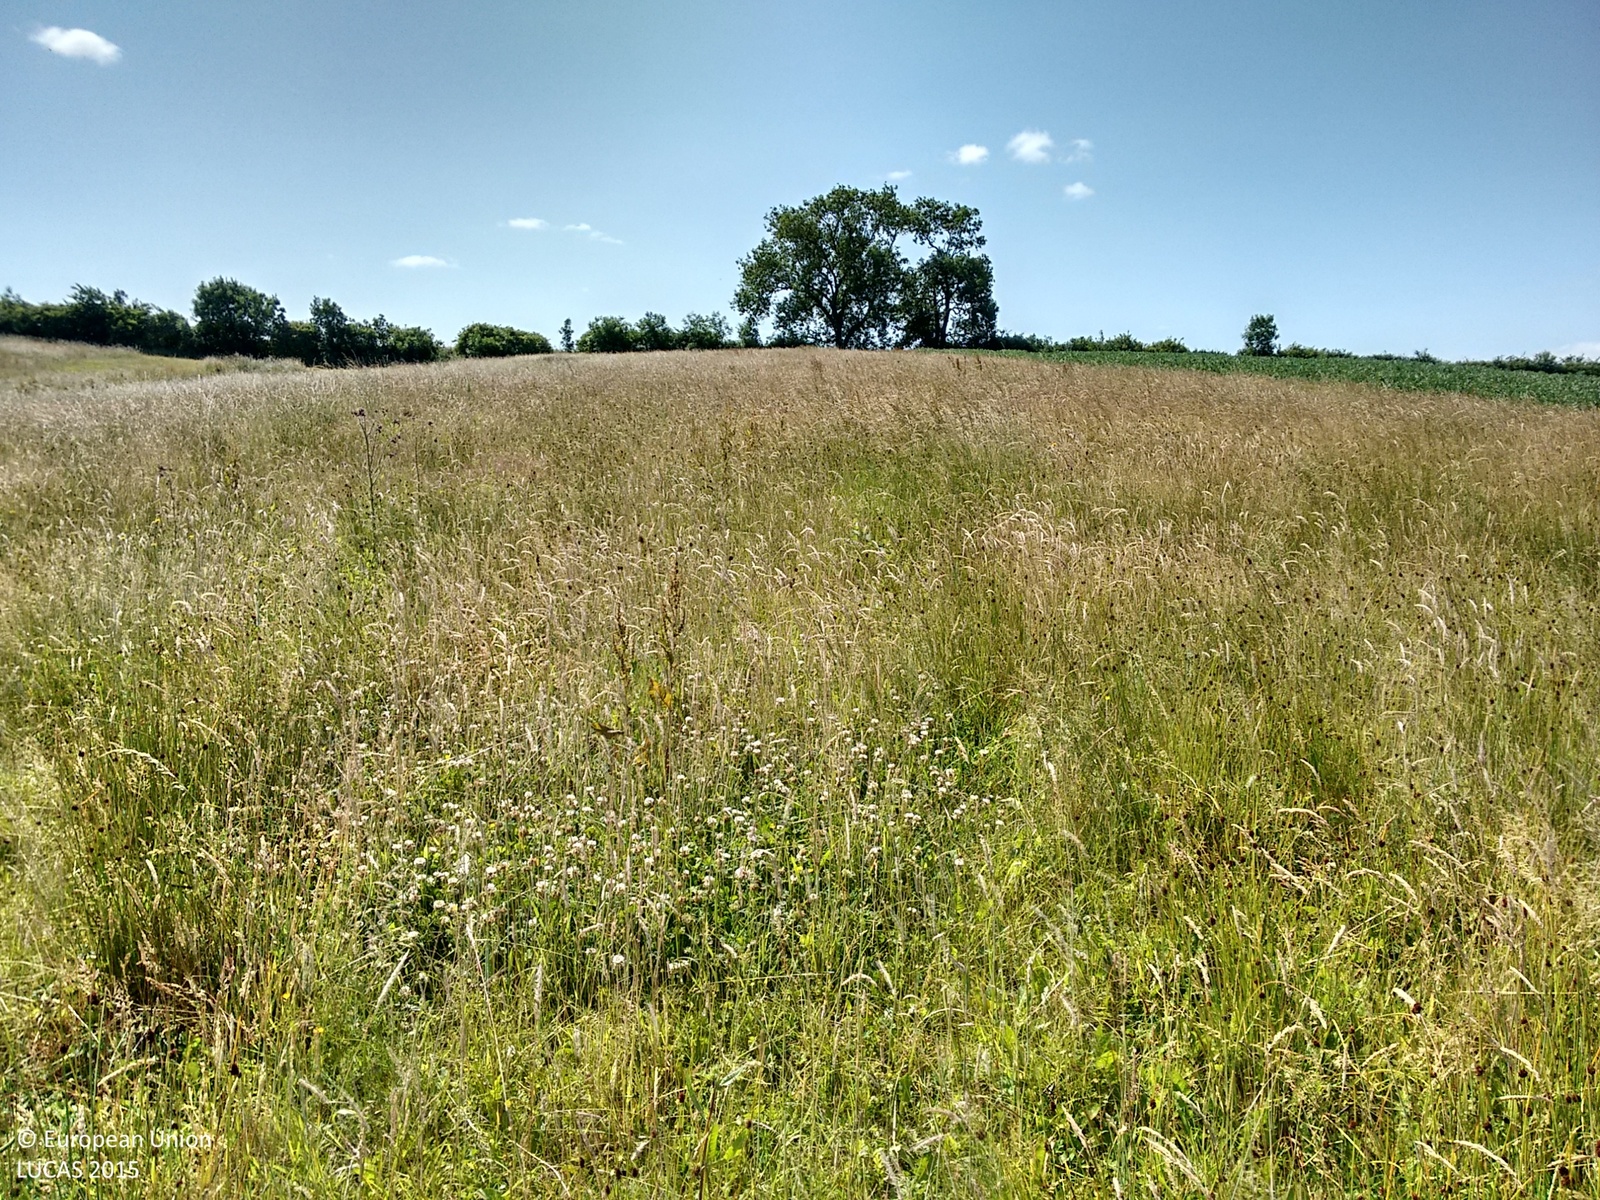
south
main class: Grassland
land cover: Grassland without tree/shrub cover
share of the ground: > 75 %
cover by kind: herbaceous plants 100 %
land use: Agriculture (excluding fallow land and kitchen gardens)
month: July
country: GB
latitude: 51.9576
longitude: -1.3561
